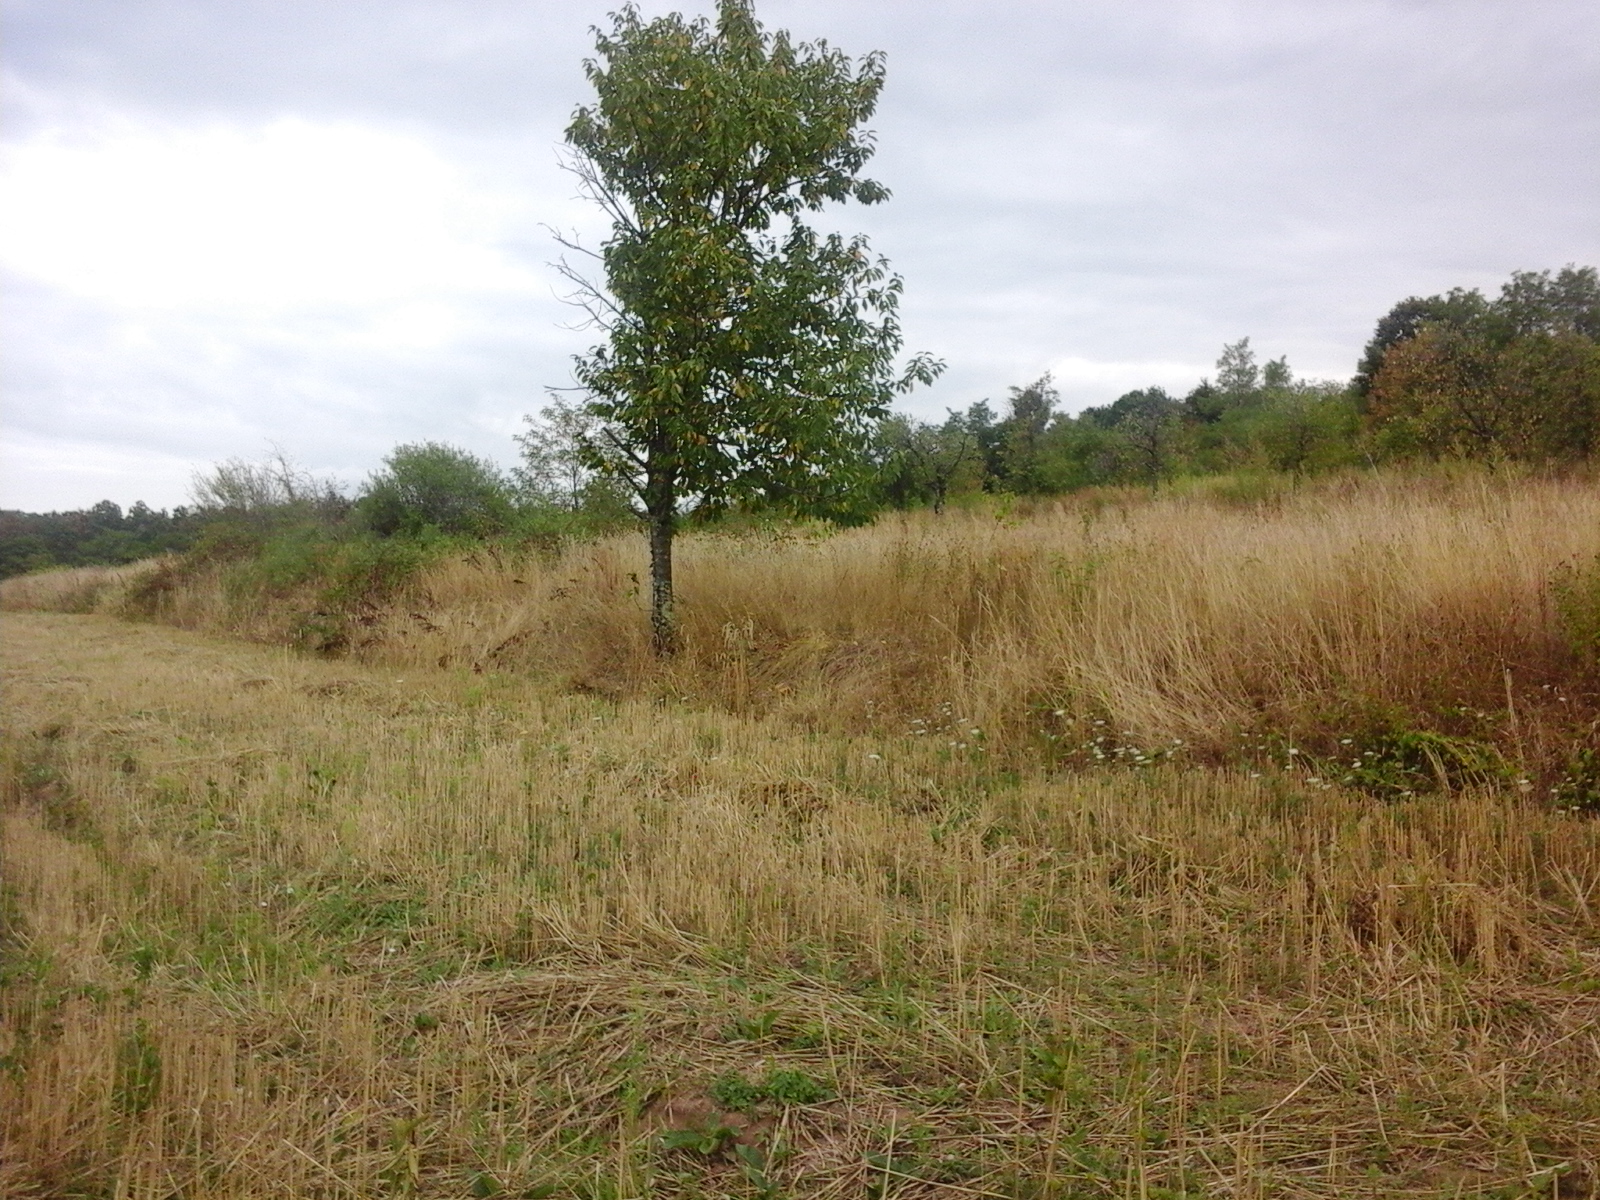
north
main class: Cropland
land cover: Common wheat
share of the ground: > 75 %
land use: Agriculture (excluding fallow land and kitchen gardens)
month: August
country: RO
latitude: 45.2151
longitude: 21.8645
